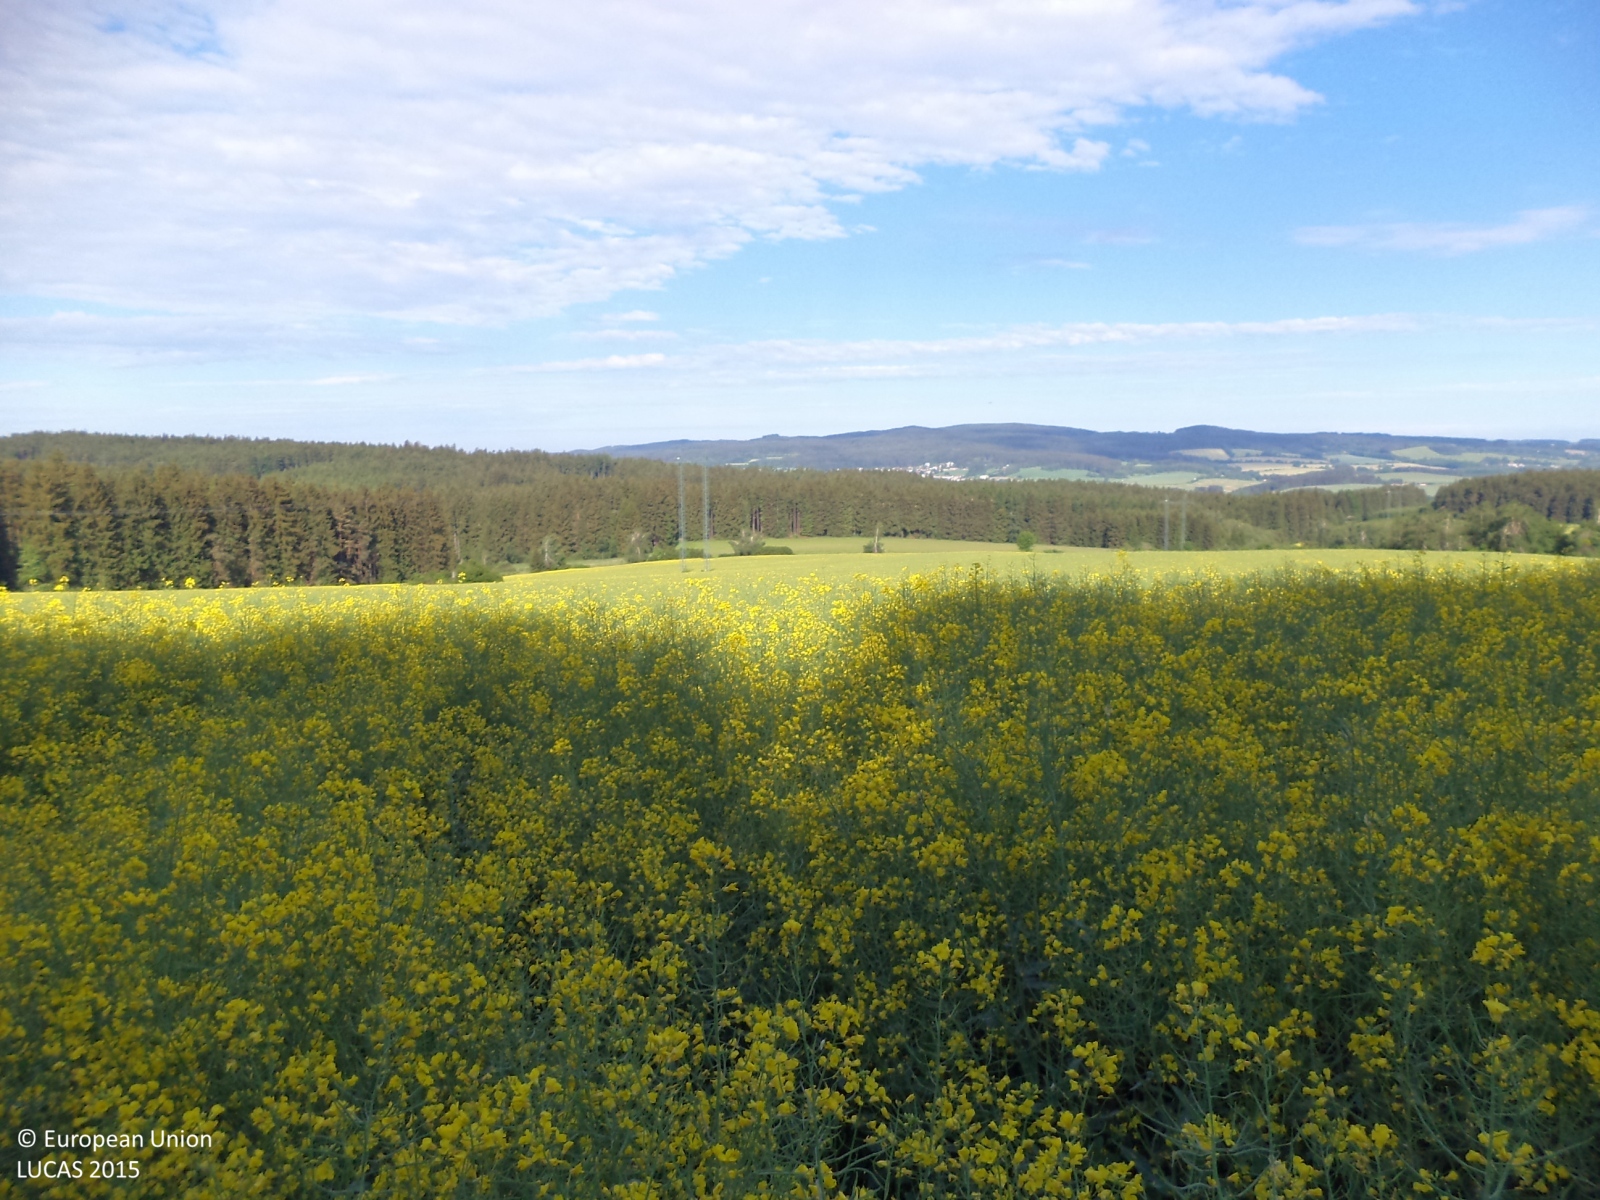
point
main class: Cropland
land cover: Rape and turnip rape
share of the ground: > 75 %
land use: Agriculture (excluding fallow land and kitchen gardens)
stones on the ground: 10 - 25 %
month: June
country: CZ
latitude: 49.3653
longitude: 15.5255
